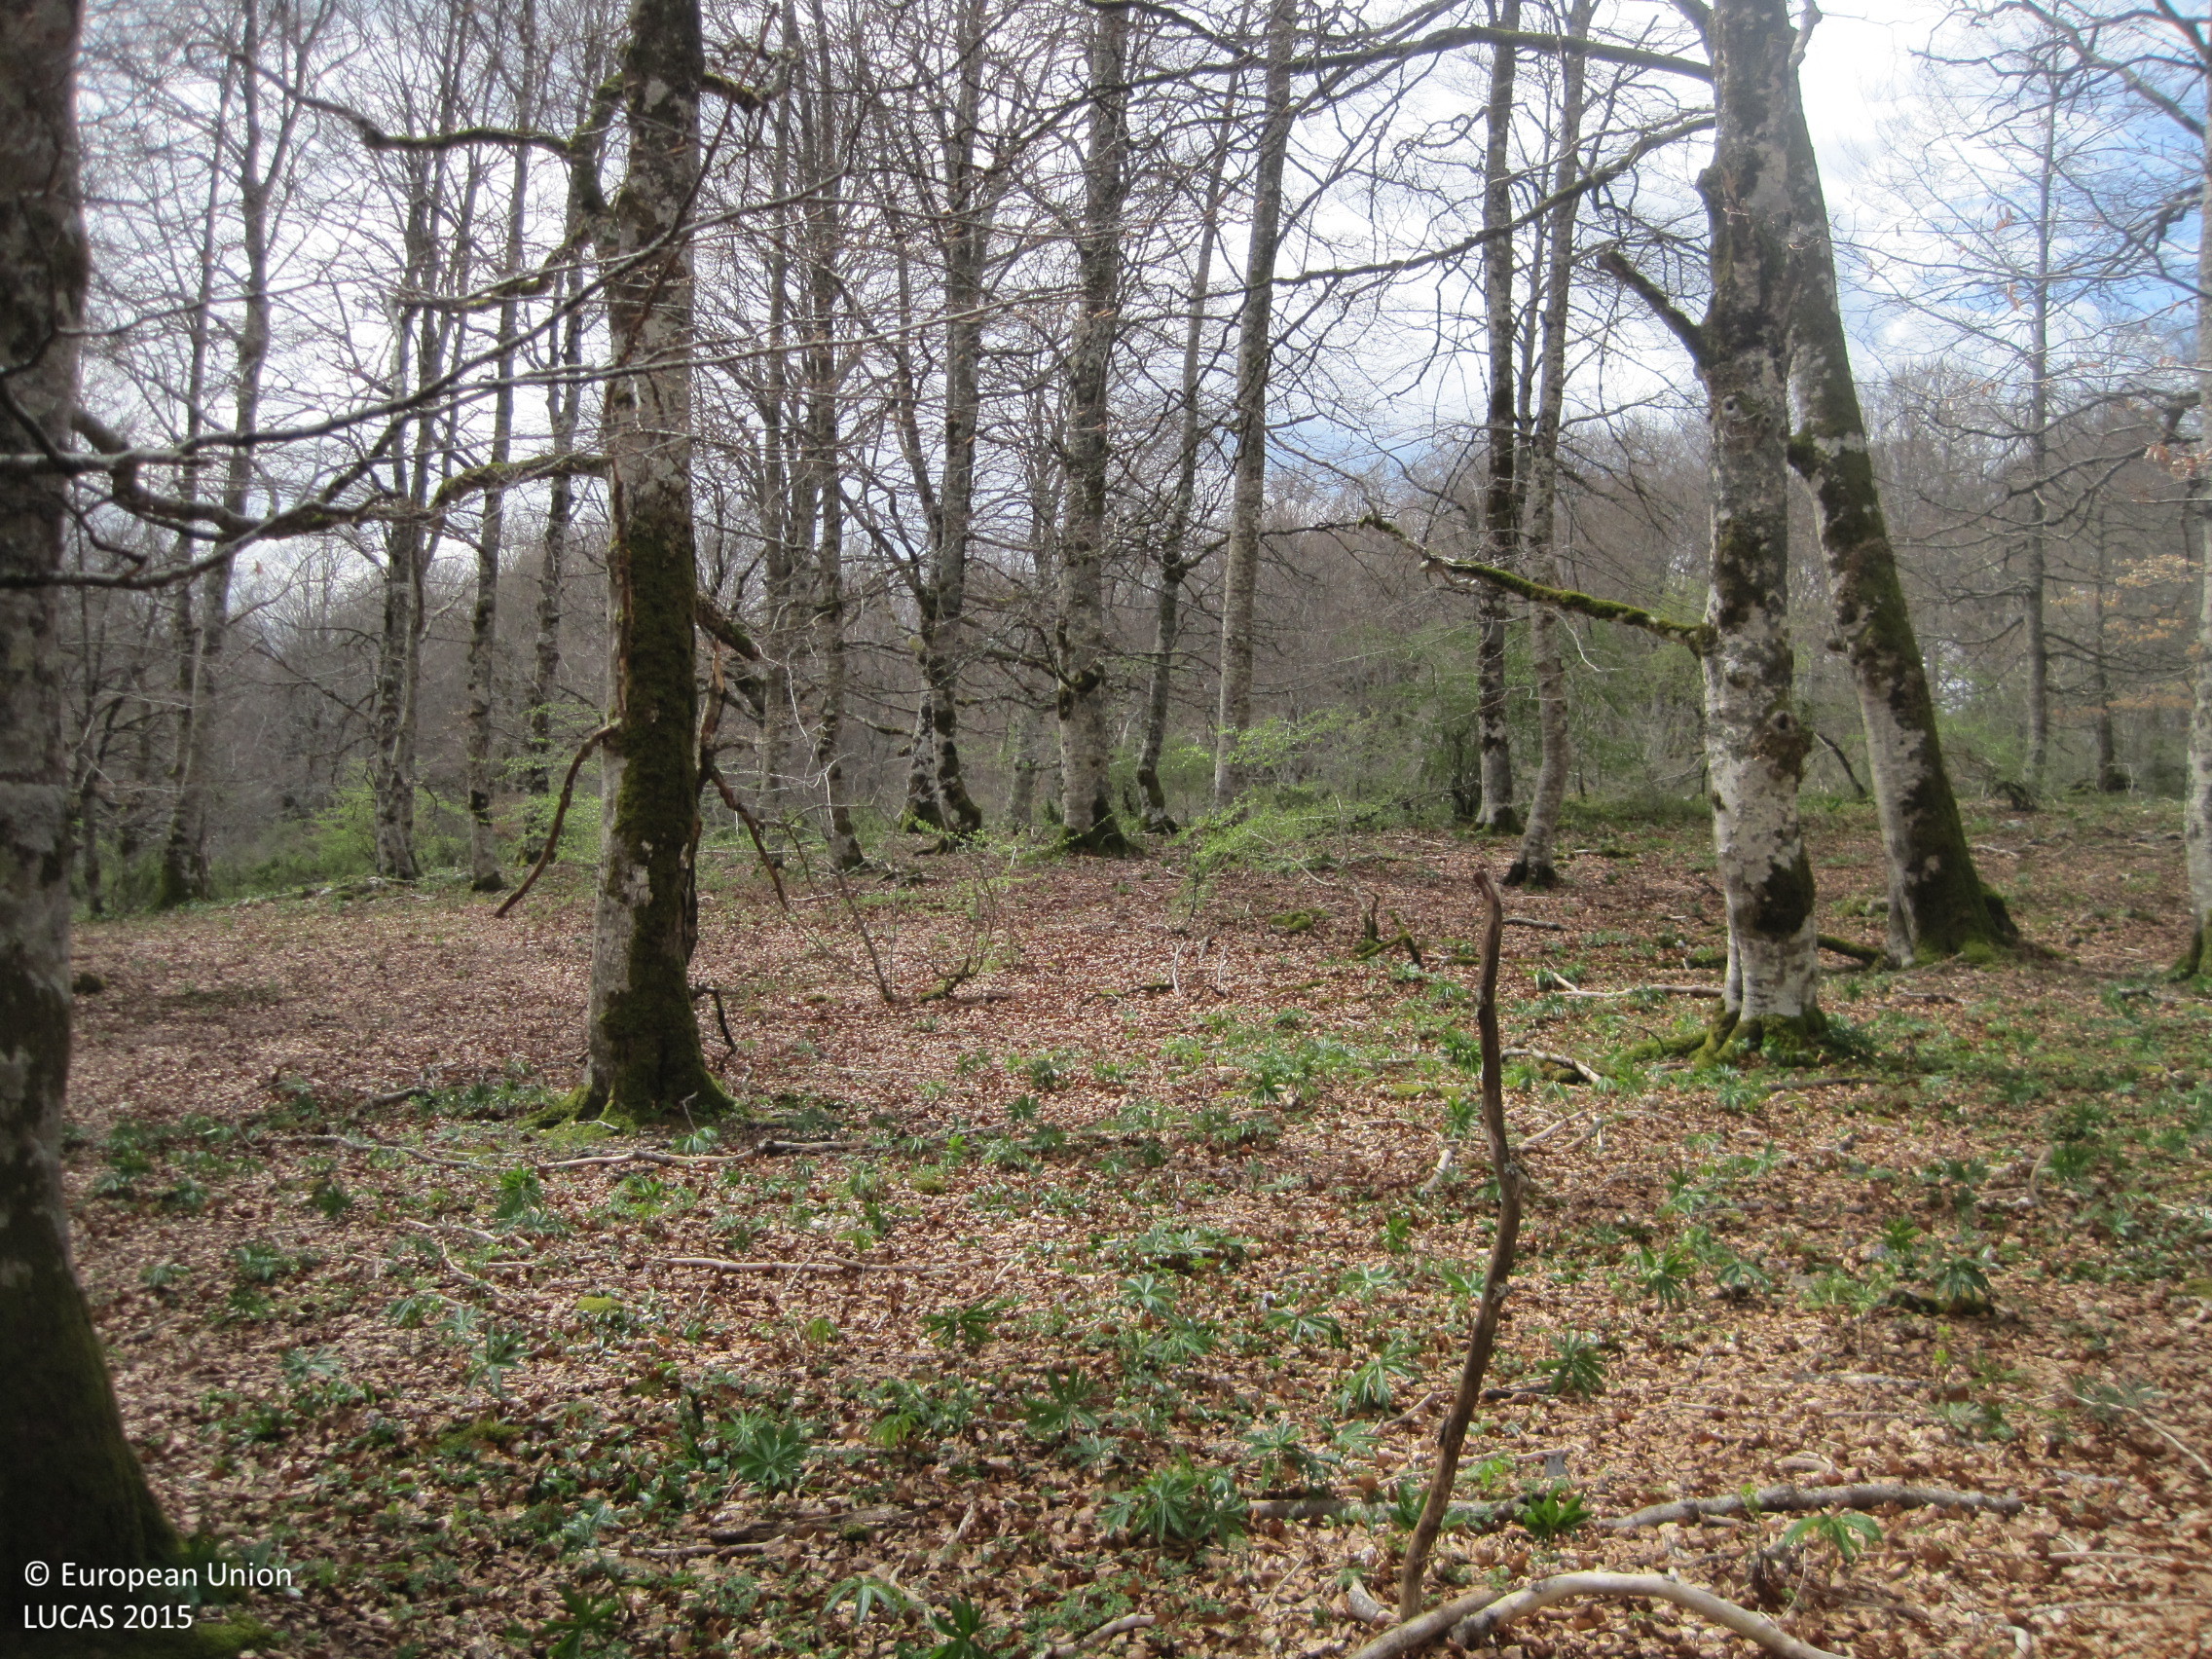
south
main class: Woodland
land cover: Broadleaved woodland
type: beech forest
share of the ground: > 75 %
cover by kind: broadleaved forest trees 100 %
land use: Forestry
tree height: > 5 m
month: April
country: ES
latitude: 42.8178
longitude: -2.2644
